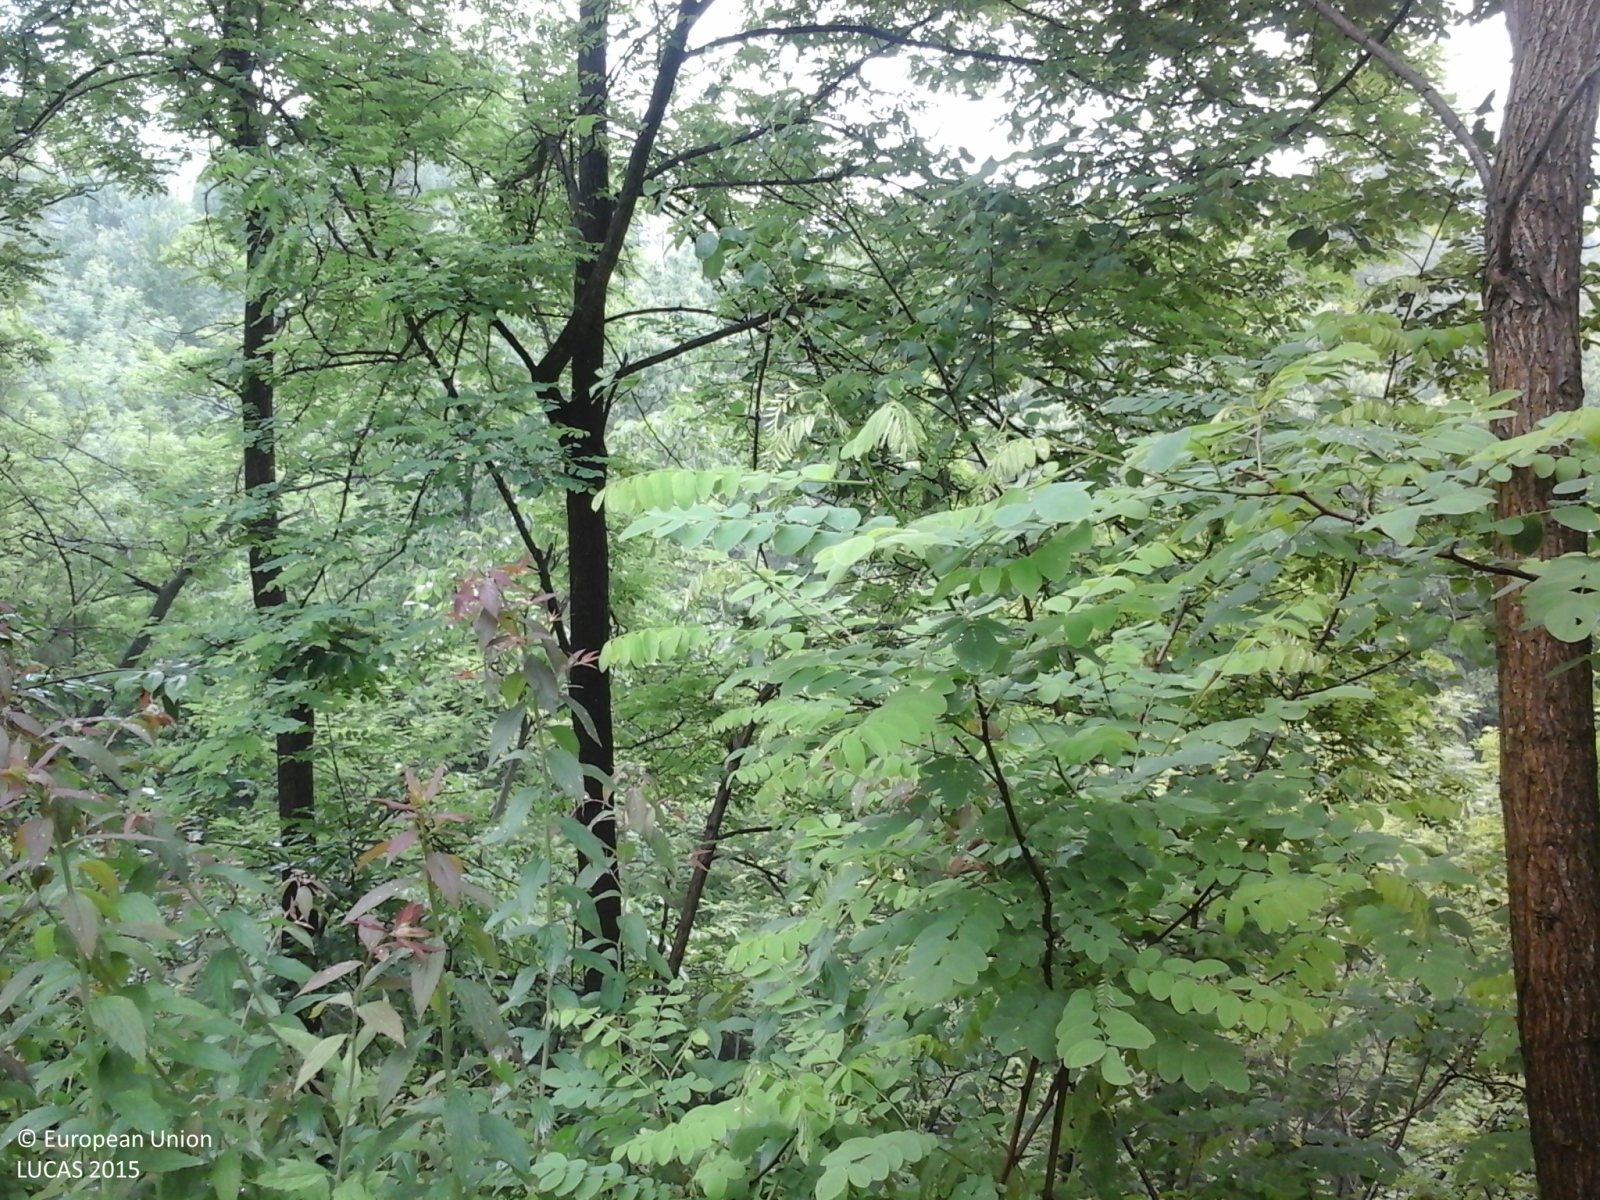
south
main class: Woodland
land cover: Broadleaved woodland
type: mesophytic deciduous forest
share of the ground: > 75 %
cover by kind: broadleaved forest trees 100 %
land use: Forestry
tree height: > 5 m
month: May
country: IT
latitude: 45.6512
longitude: 8.1935
